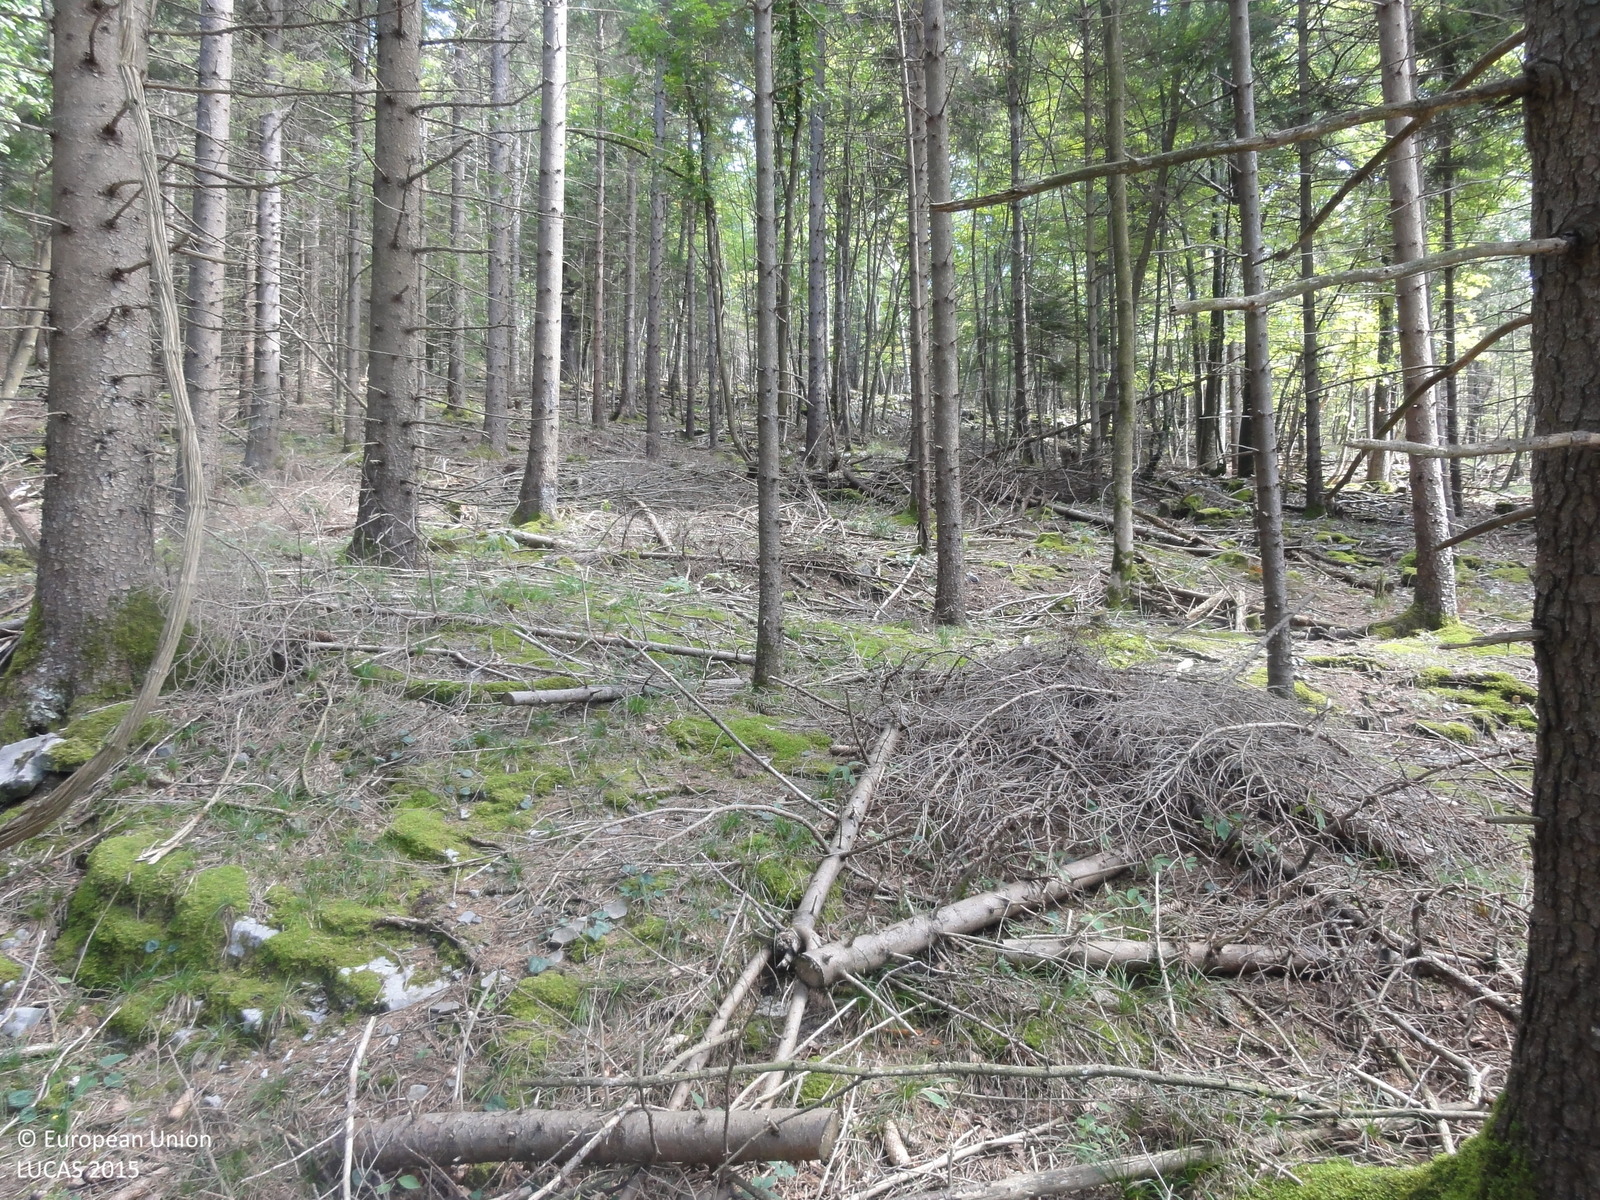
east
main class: Woodland
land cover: Spruce dominated coniferous woodland
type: hemiboreal forest and nemoral coniferous forest and mixed broadleaved-coniferous forest
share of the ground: > 75 %
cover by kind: coniferous forest trees 85 %, unconsolidated bare surface 10 %, broadleaved forest trees 5 %
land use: Forestry
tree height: > 5 m
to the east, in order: Spruce dominated coniferous woodland; Spruce dominated mixed woodland; Spruce dominated coniferous woodland; Spruce dominated mixed woodland; Broadleaved woodland
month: September
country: SI
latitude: 45.7280
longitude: 15.0204
